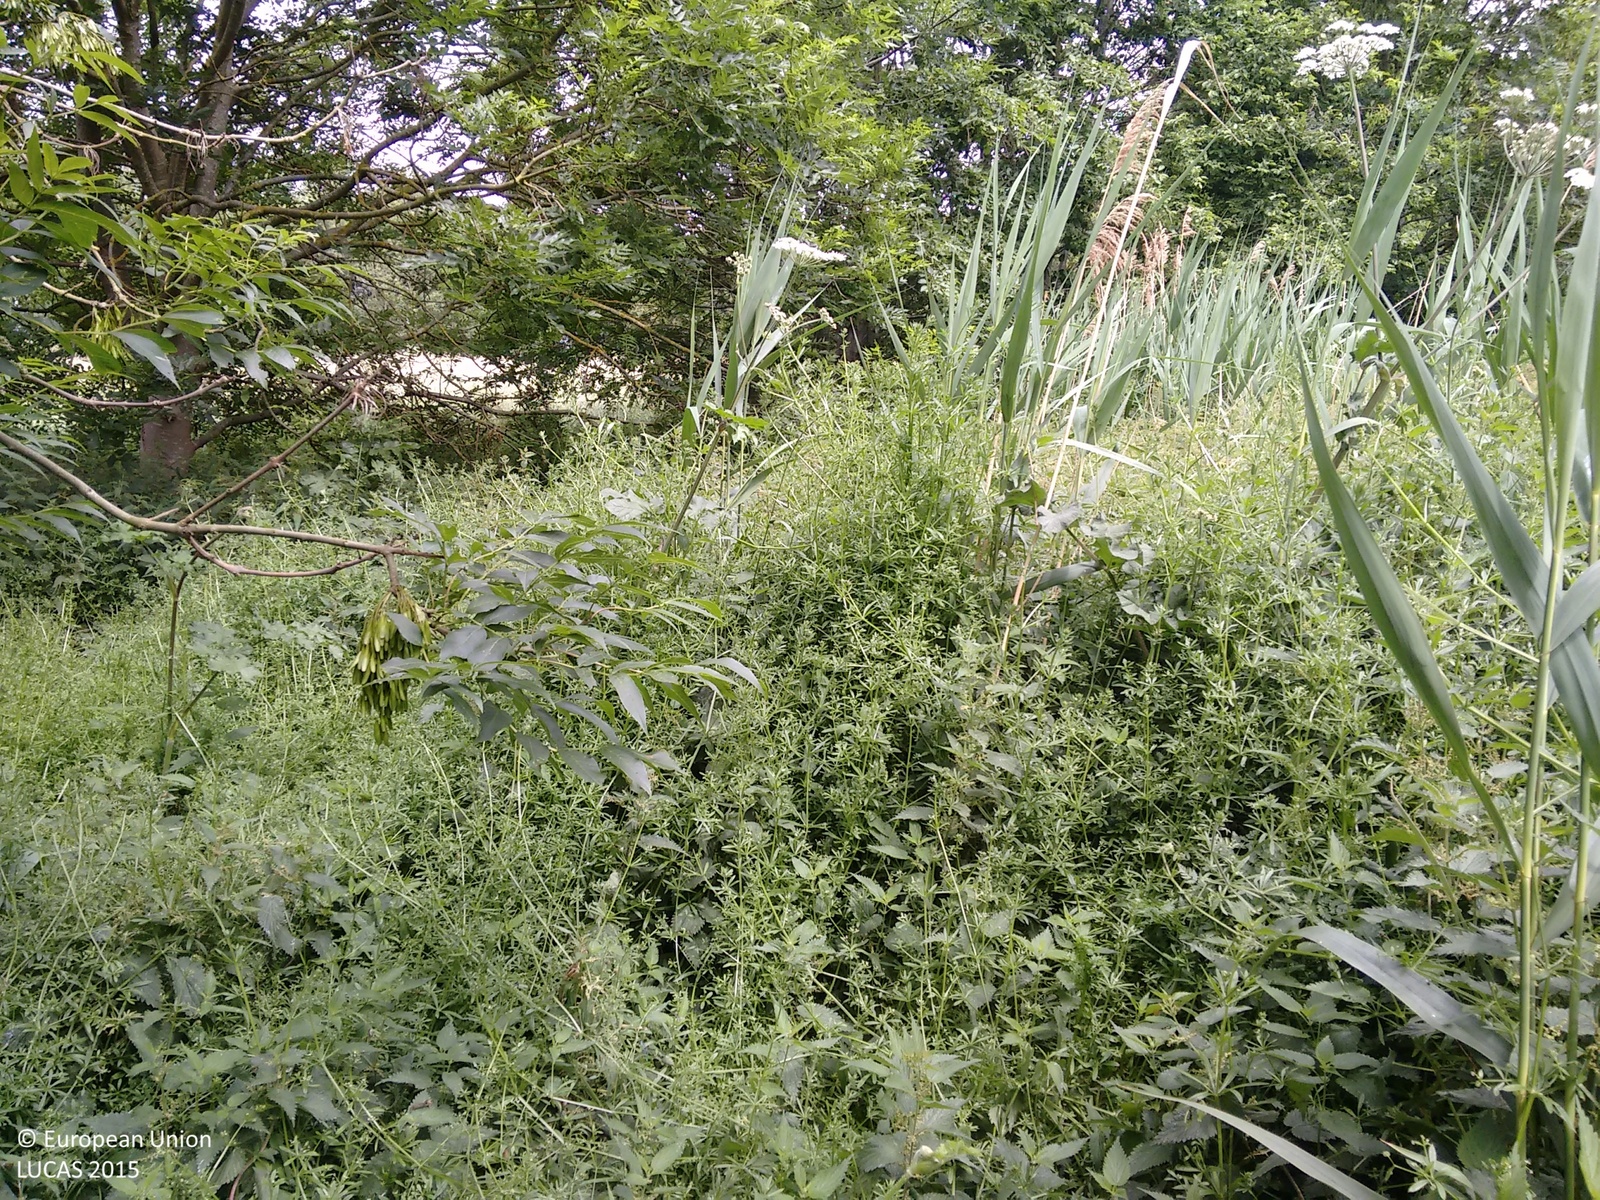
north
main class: Grassland
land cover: Grassland with sparse tree/shrub cover
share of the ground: > 75 %
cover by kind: herbaceous plants 95 %, broadleaved forest trees 5 %
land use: Semi-natural and natural areas not in use
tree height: < 5 m
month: June
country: GB
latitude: 52.5912
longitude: 0.0335
